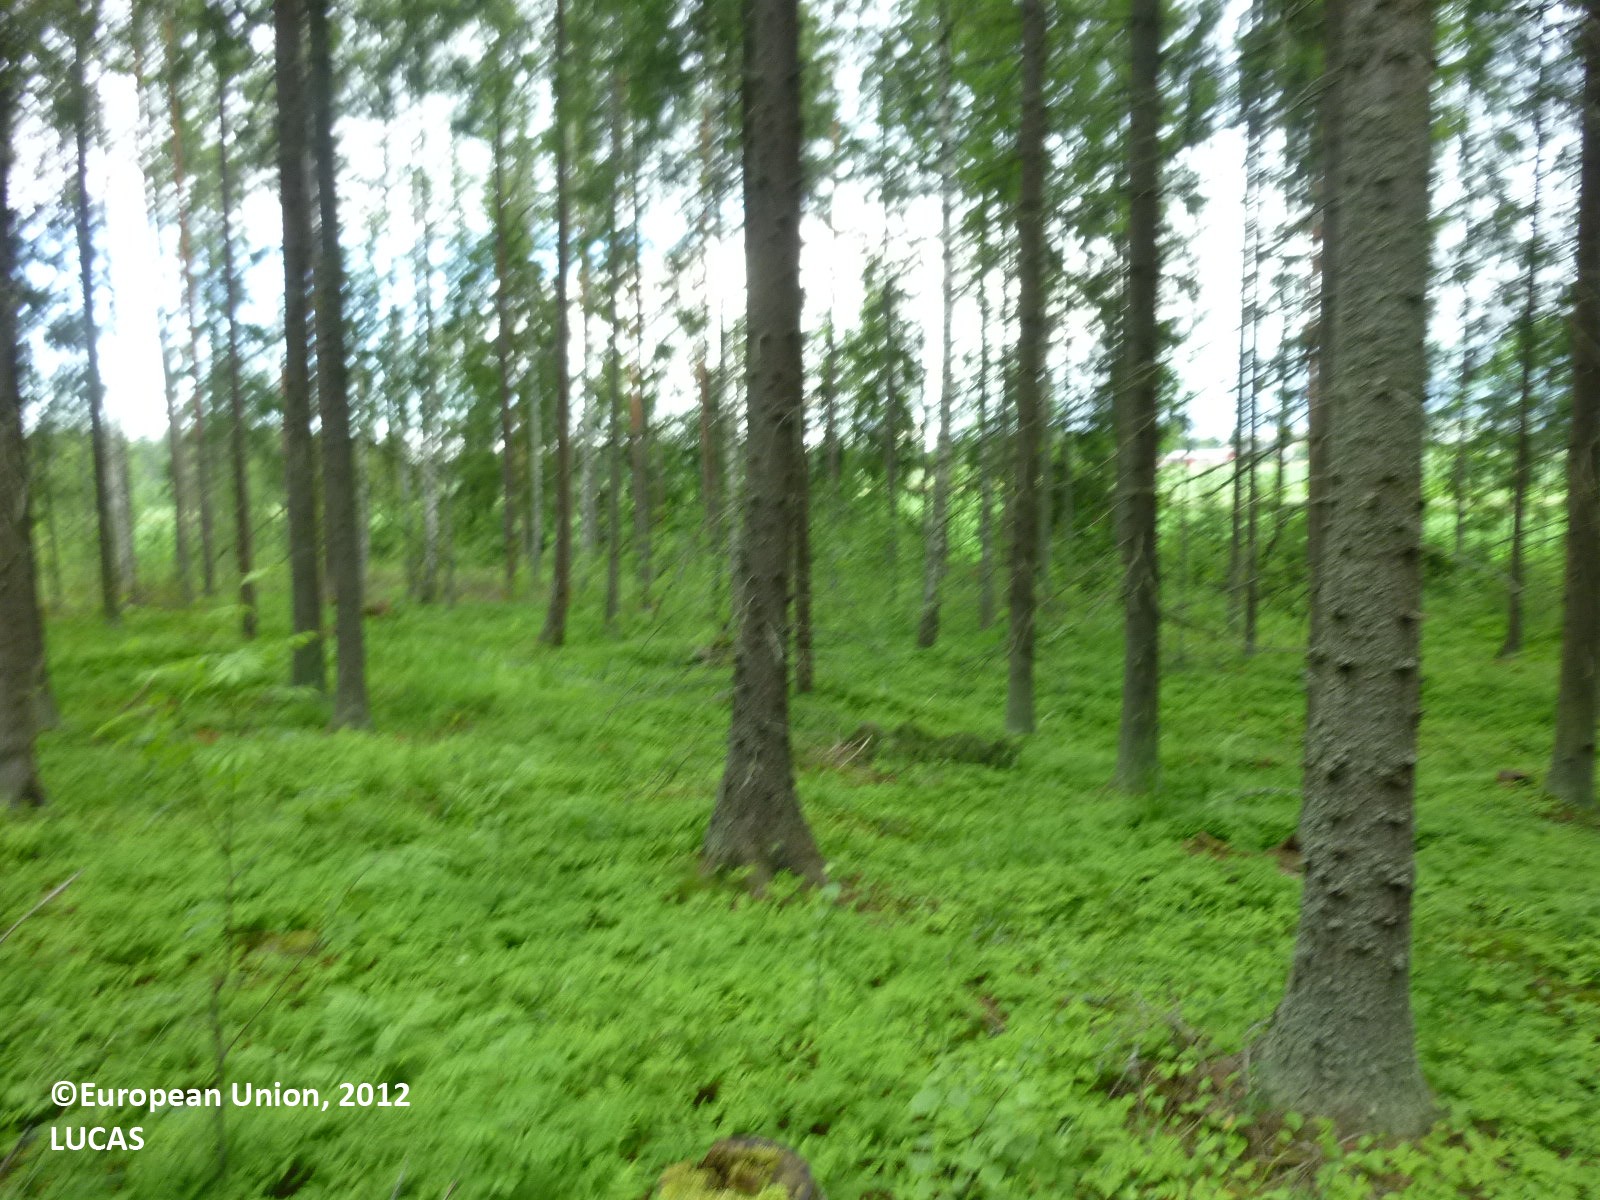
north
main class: Woodland
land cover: Spruce dominated coniferous woodland
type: boreal forest
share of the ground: > 75 %
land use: Forestry
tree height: > 5 m
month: July
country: FI
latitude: 61.3064
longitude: 22.0263
